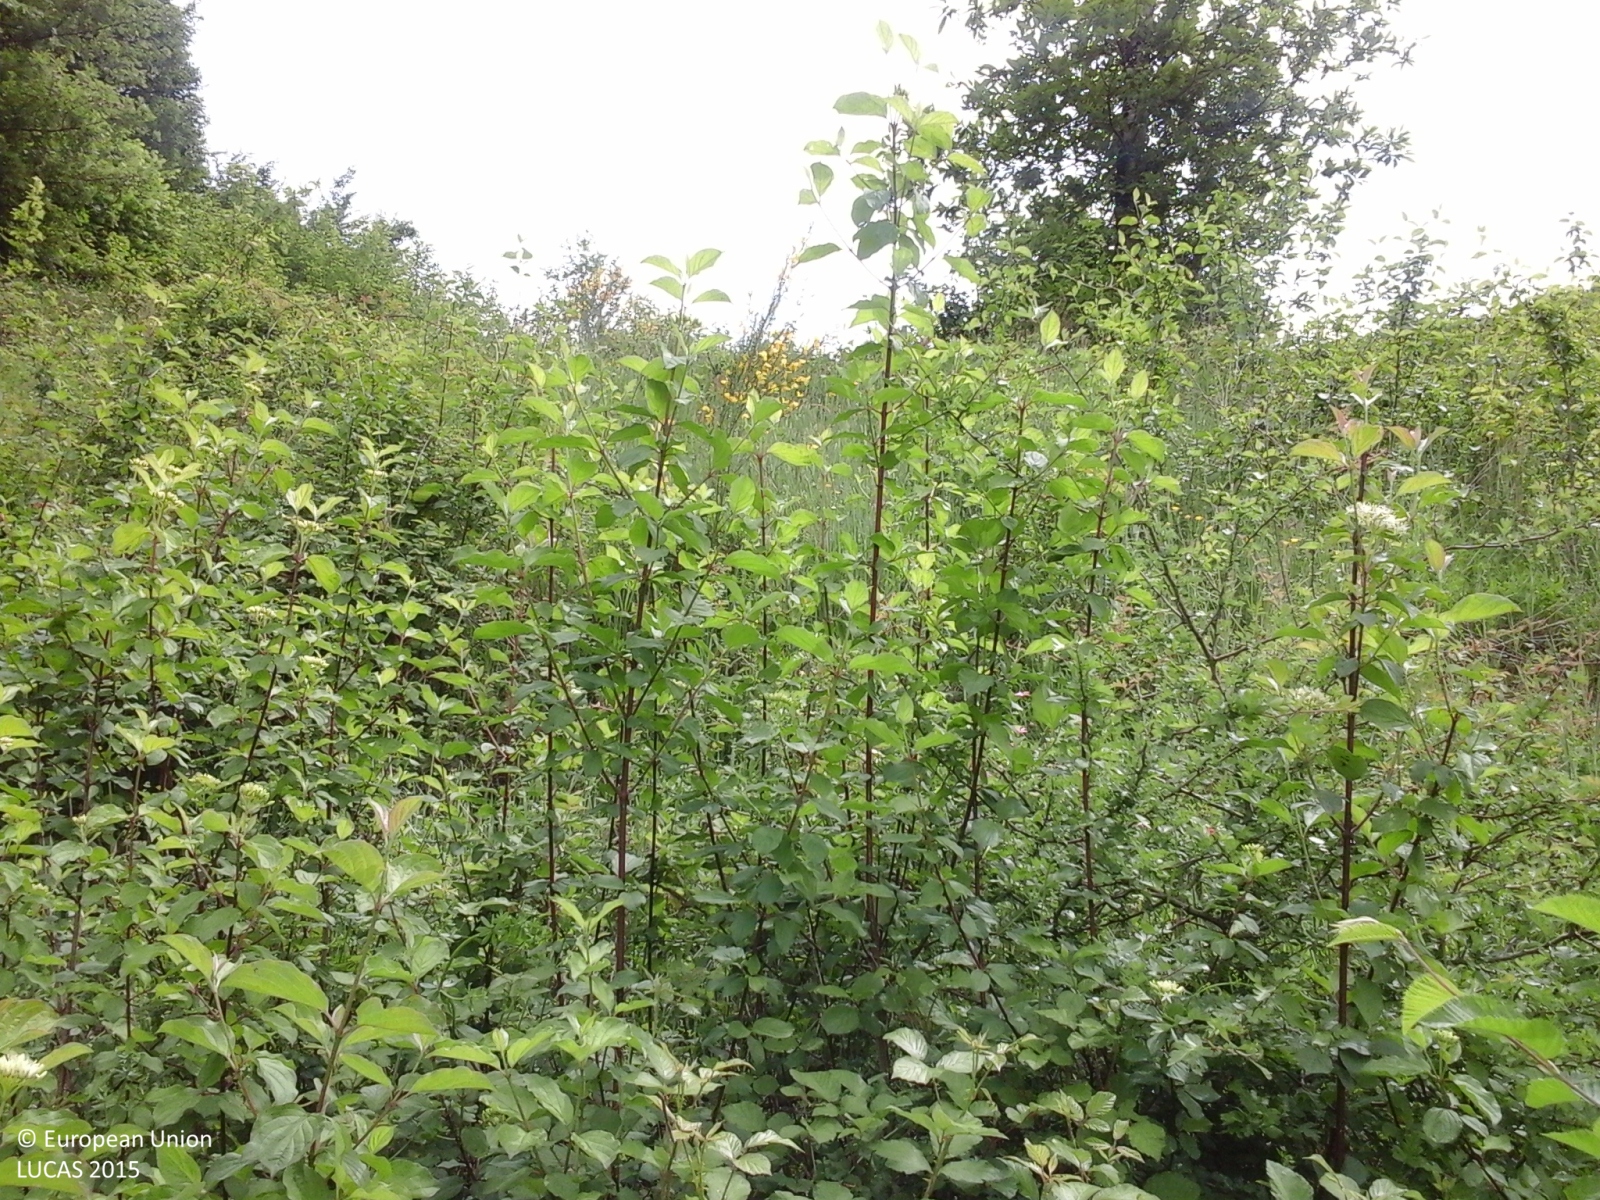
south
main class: Grassland
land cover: Grassland with sparse tree/shrub cover
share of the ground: > 75 %
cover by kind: herbaceous plants 85 %, shrubs 10 %, broadleaved forest trees 5 %
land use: Semi-natural and natural areas not in use
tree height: < 5 m
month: May
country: IT
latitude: 44.0191
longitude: 11.1822
